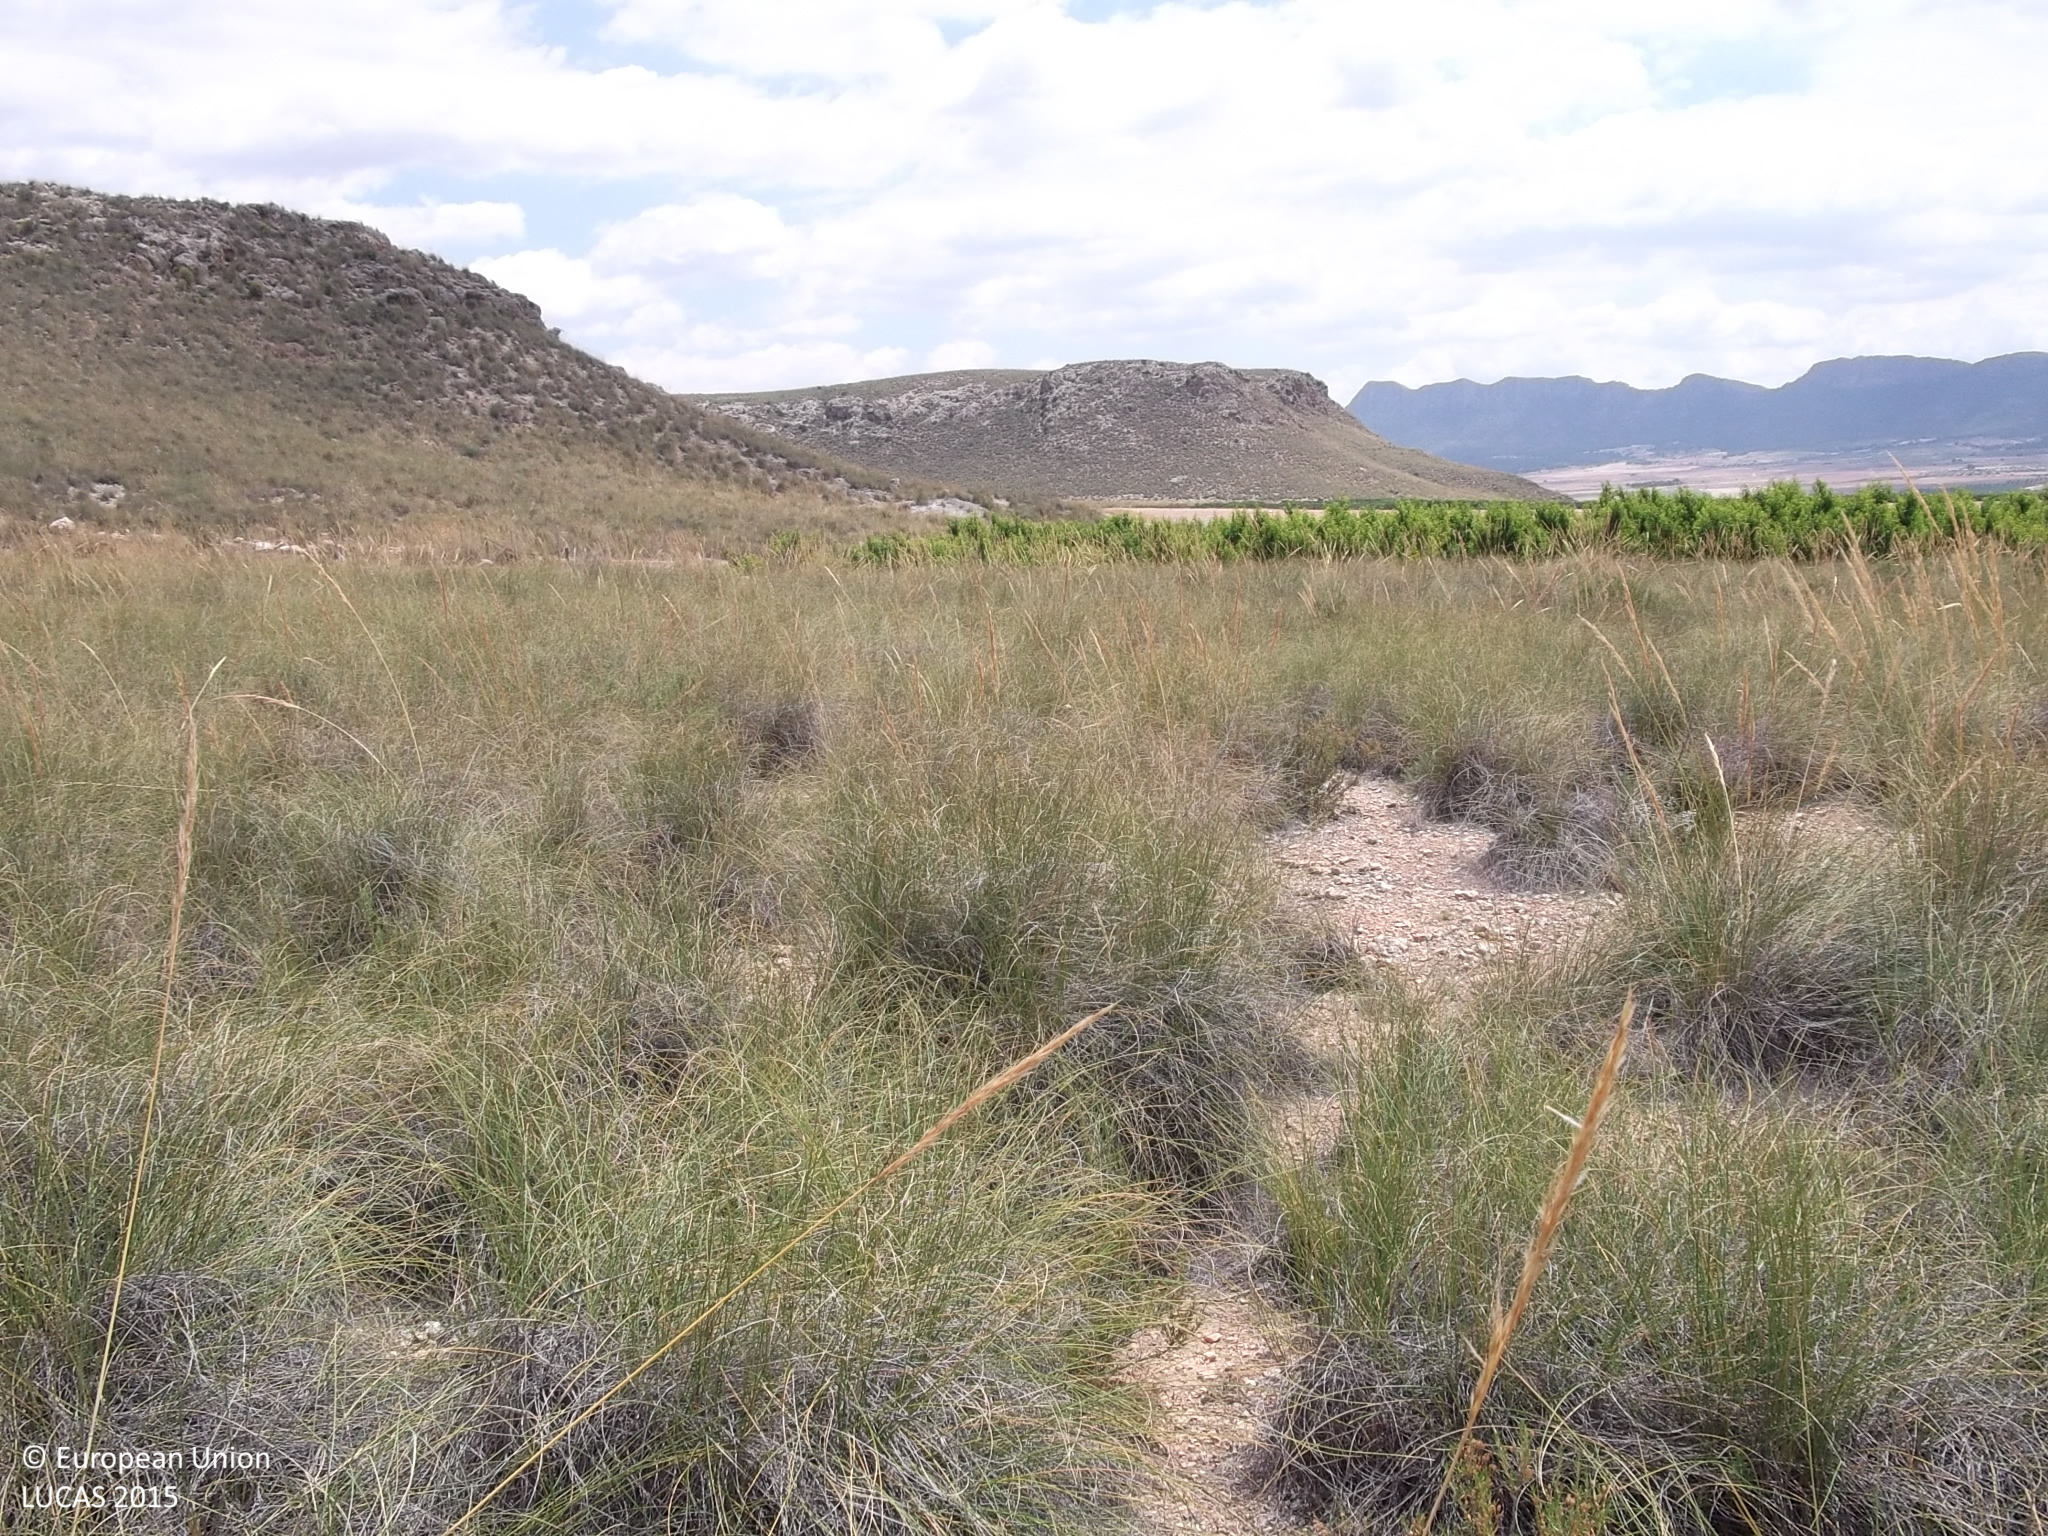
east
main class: Shrubland
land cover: Shrubland without tree cover
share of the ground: 25 - 50 %
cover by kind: shrubs 40 %, herbaceous plants 40 %, consolidated bare surface 20 %
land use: Semi-natural and natural areas not in use
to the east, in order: Shrubland without tree cover; Tracks; Other fruit trees and berries; Tracks; Other bare soil; Tracks; Shrubland without tree cover
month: May
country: ES
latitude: 38.3888
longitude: -1.4506
